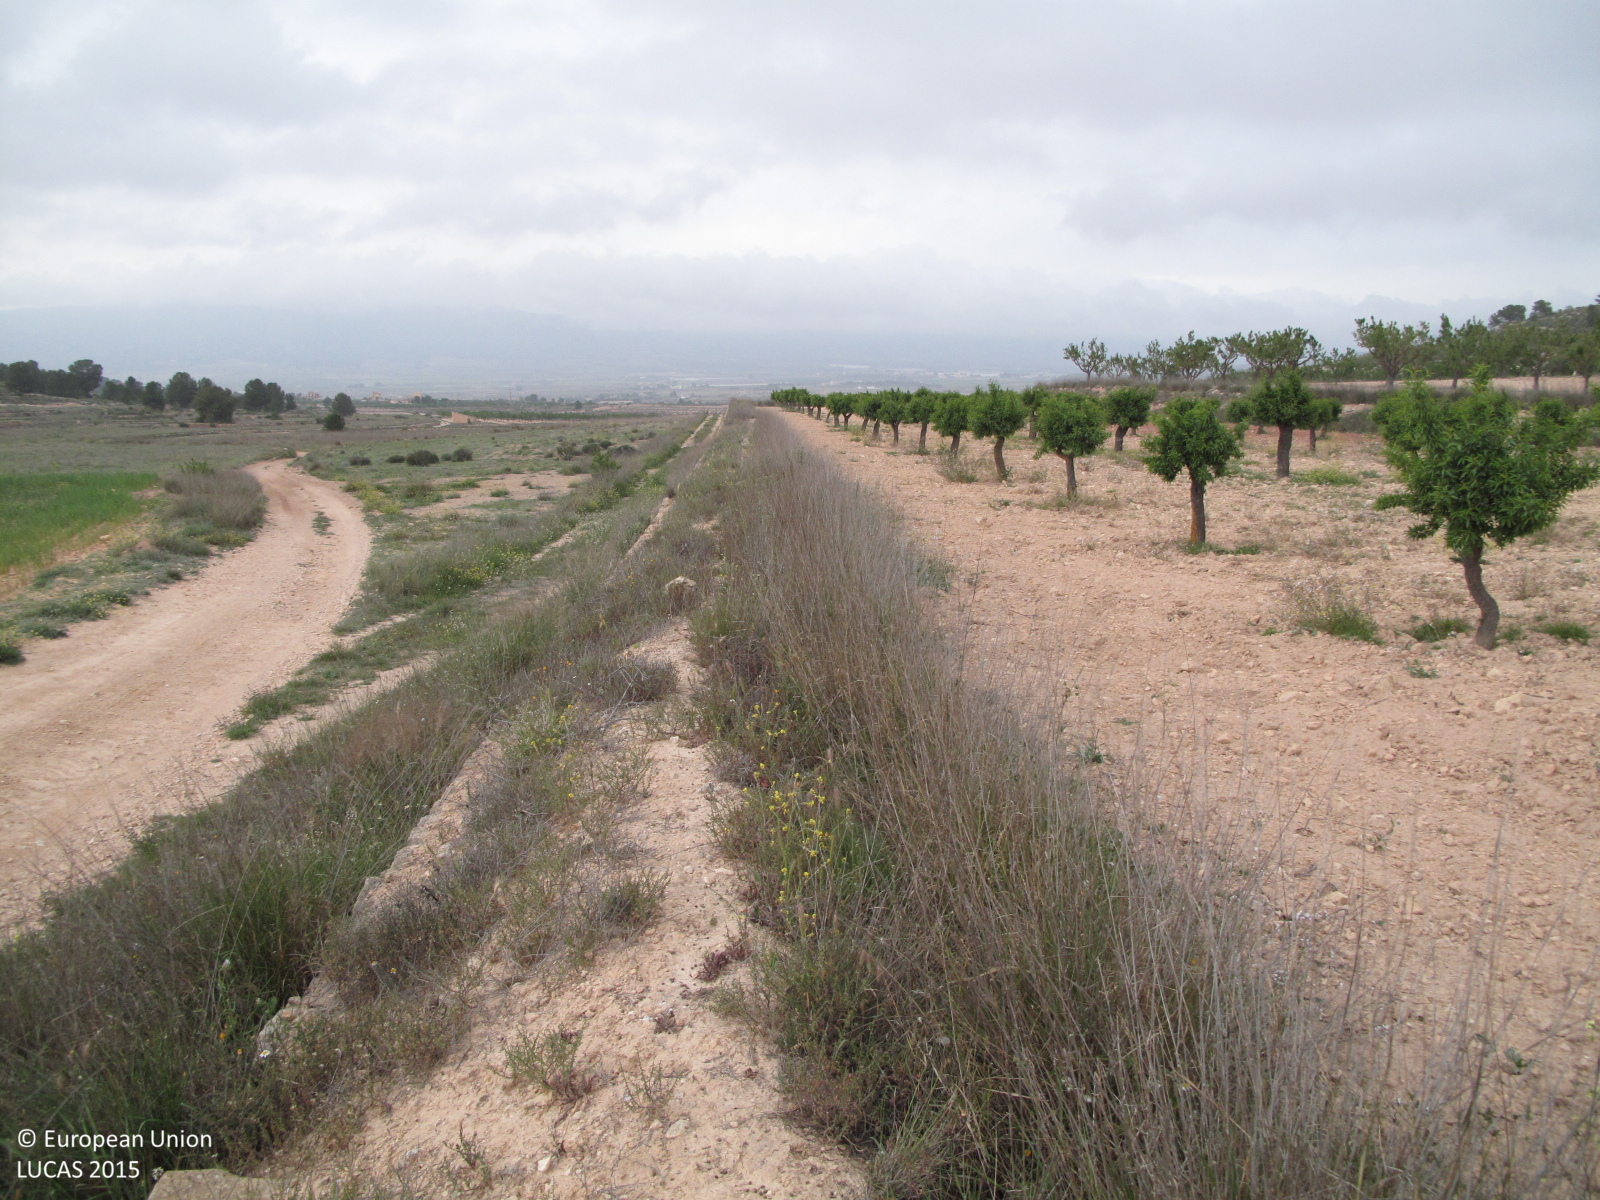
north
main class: Cropland
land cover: Nuts trees
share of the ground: < 10 %
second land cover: Other bare soil
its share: > 75 %
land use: Agriculture (excluding fallow land and kitchen gardens)
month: April
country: ES
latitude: 38.4266
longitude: -0.9735
